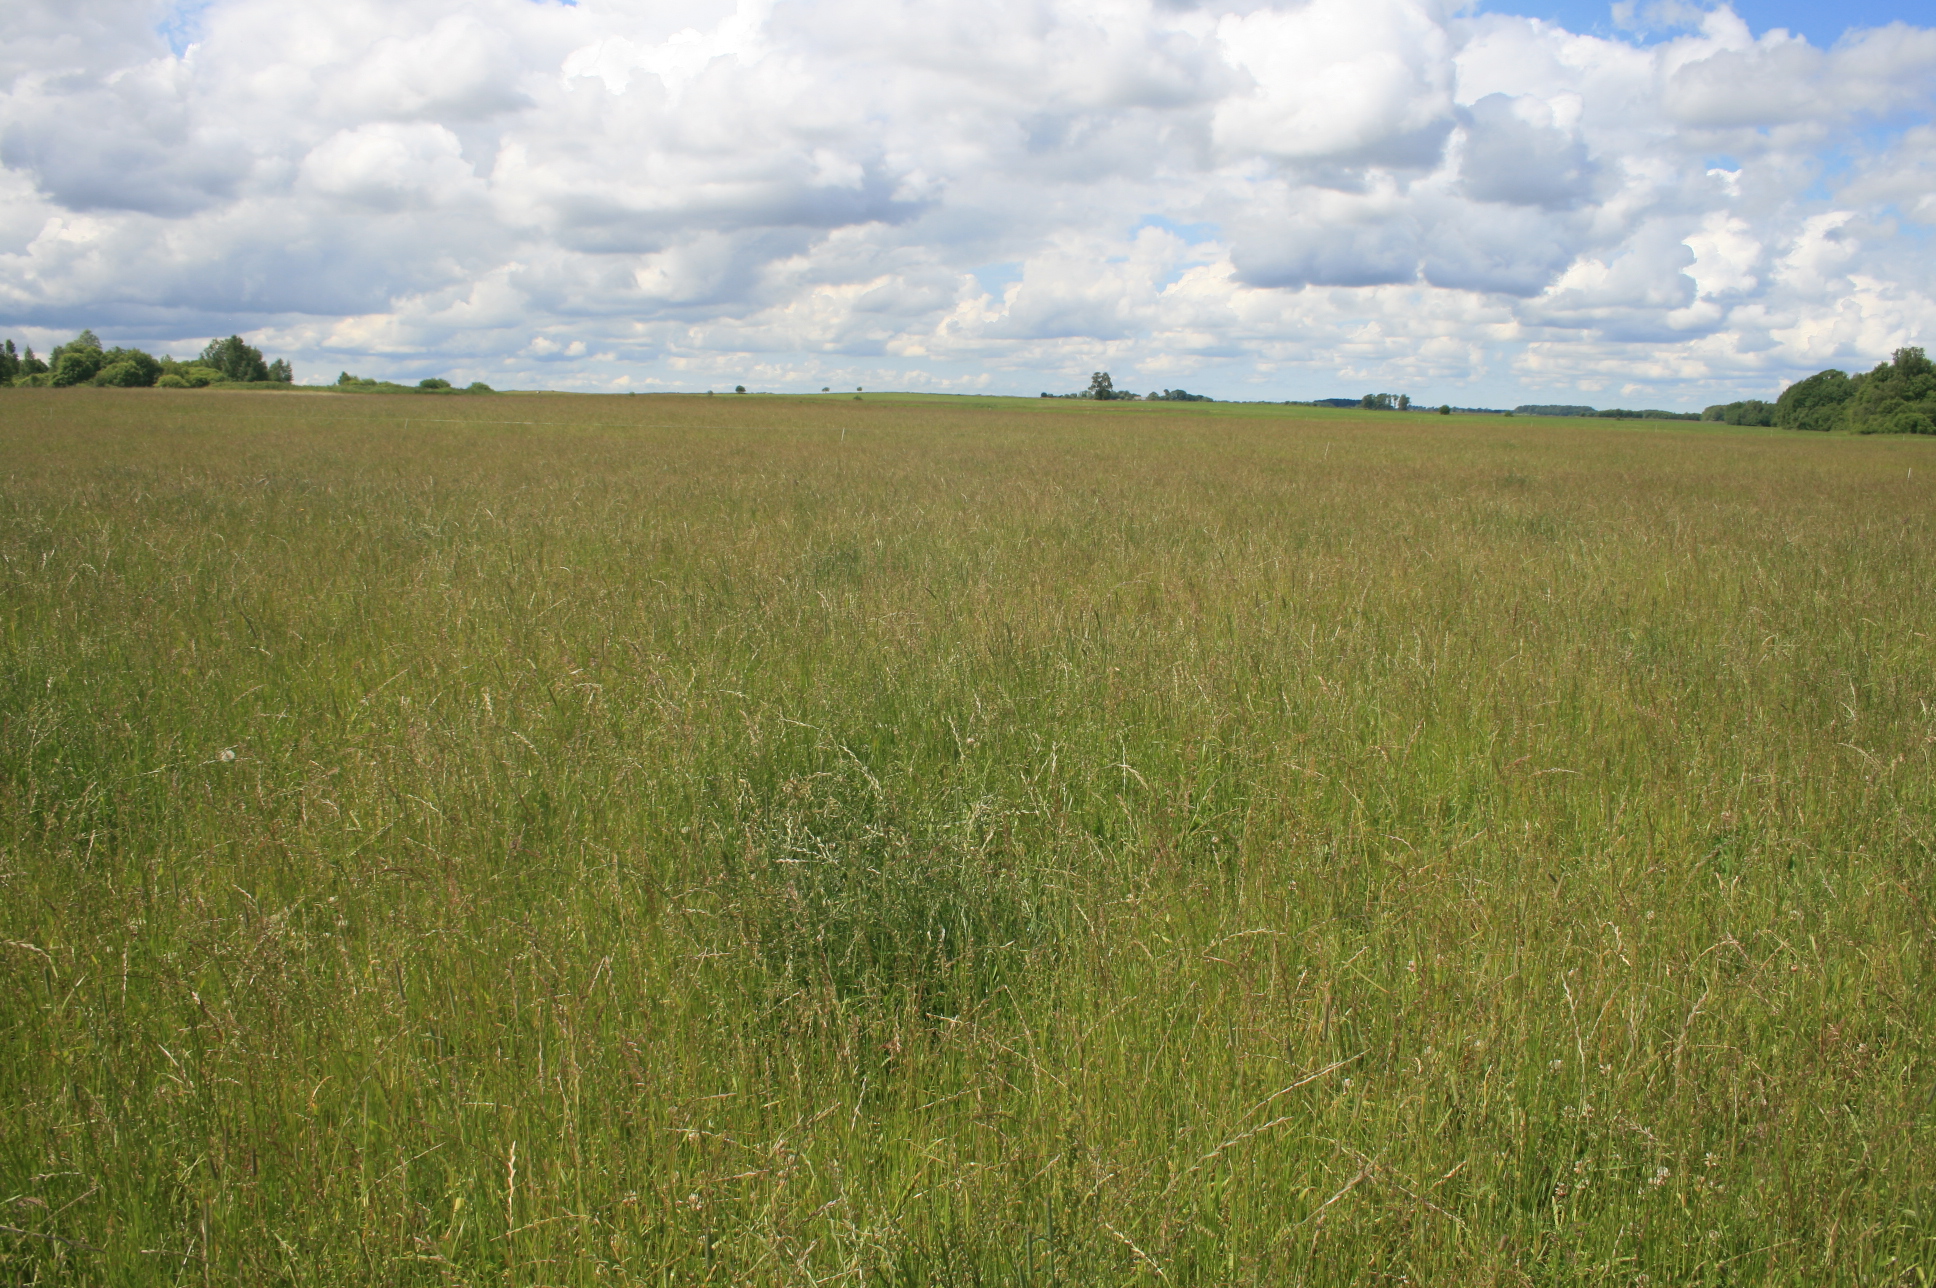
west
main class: Grassland
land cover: Grassland without tree/shrub cover
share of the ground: > 75 %
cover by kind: herbaceous plants 100 %
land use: Agriculture (excluding fallow land and kitchen gardens)
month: June
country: LT
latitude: 55.2703
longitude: 22.0637
